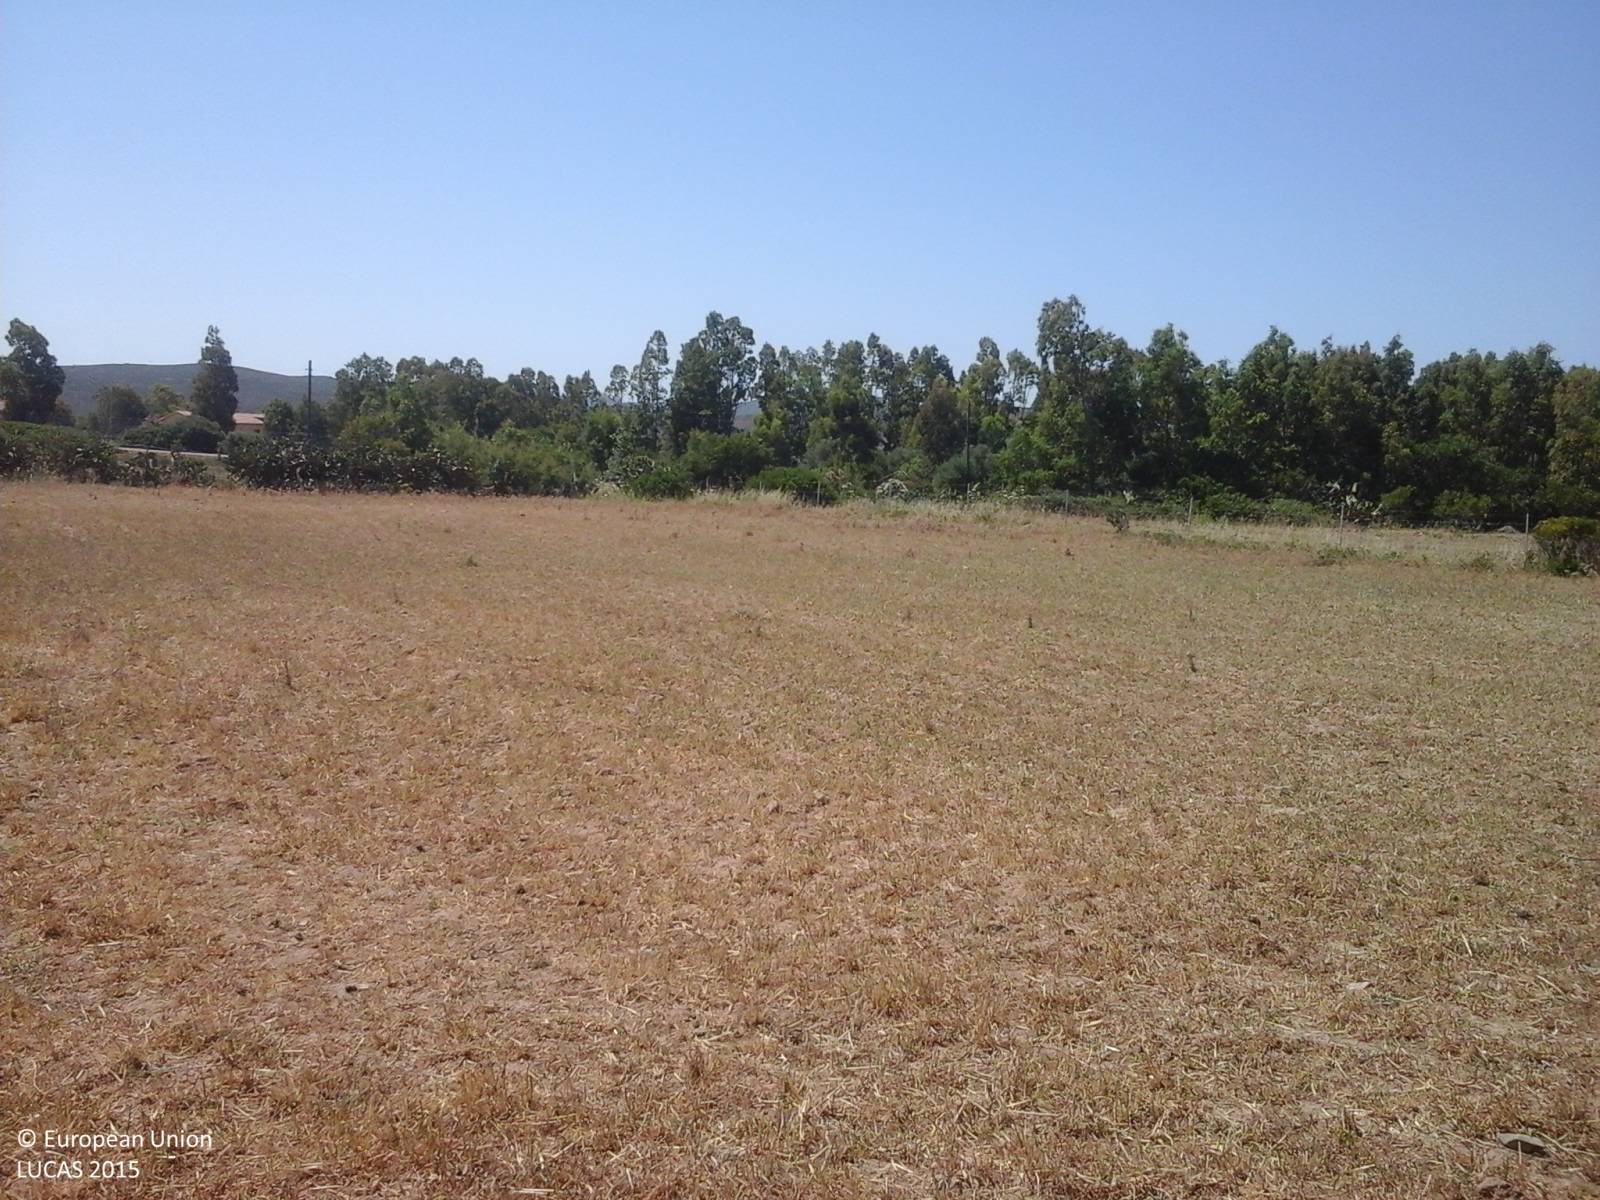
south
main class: Shrubland
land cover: Shrubland without tree cover
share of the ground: > 75 %
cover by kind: herbaceous plants 60 %, consolidated bare surface 25 %, shrubs 15 %
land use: Agriculture (excluding fallow land and kitchen gardens)
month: June
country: IT
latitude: 38.9903
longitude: 8.6808
